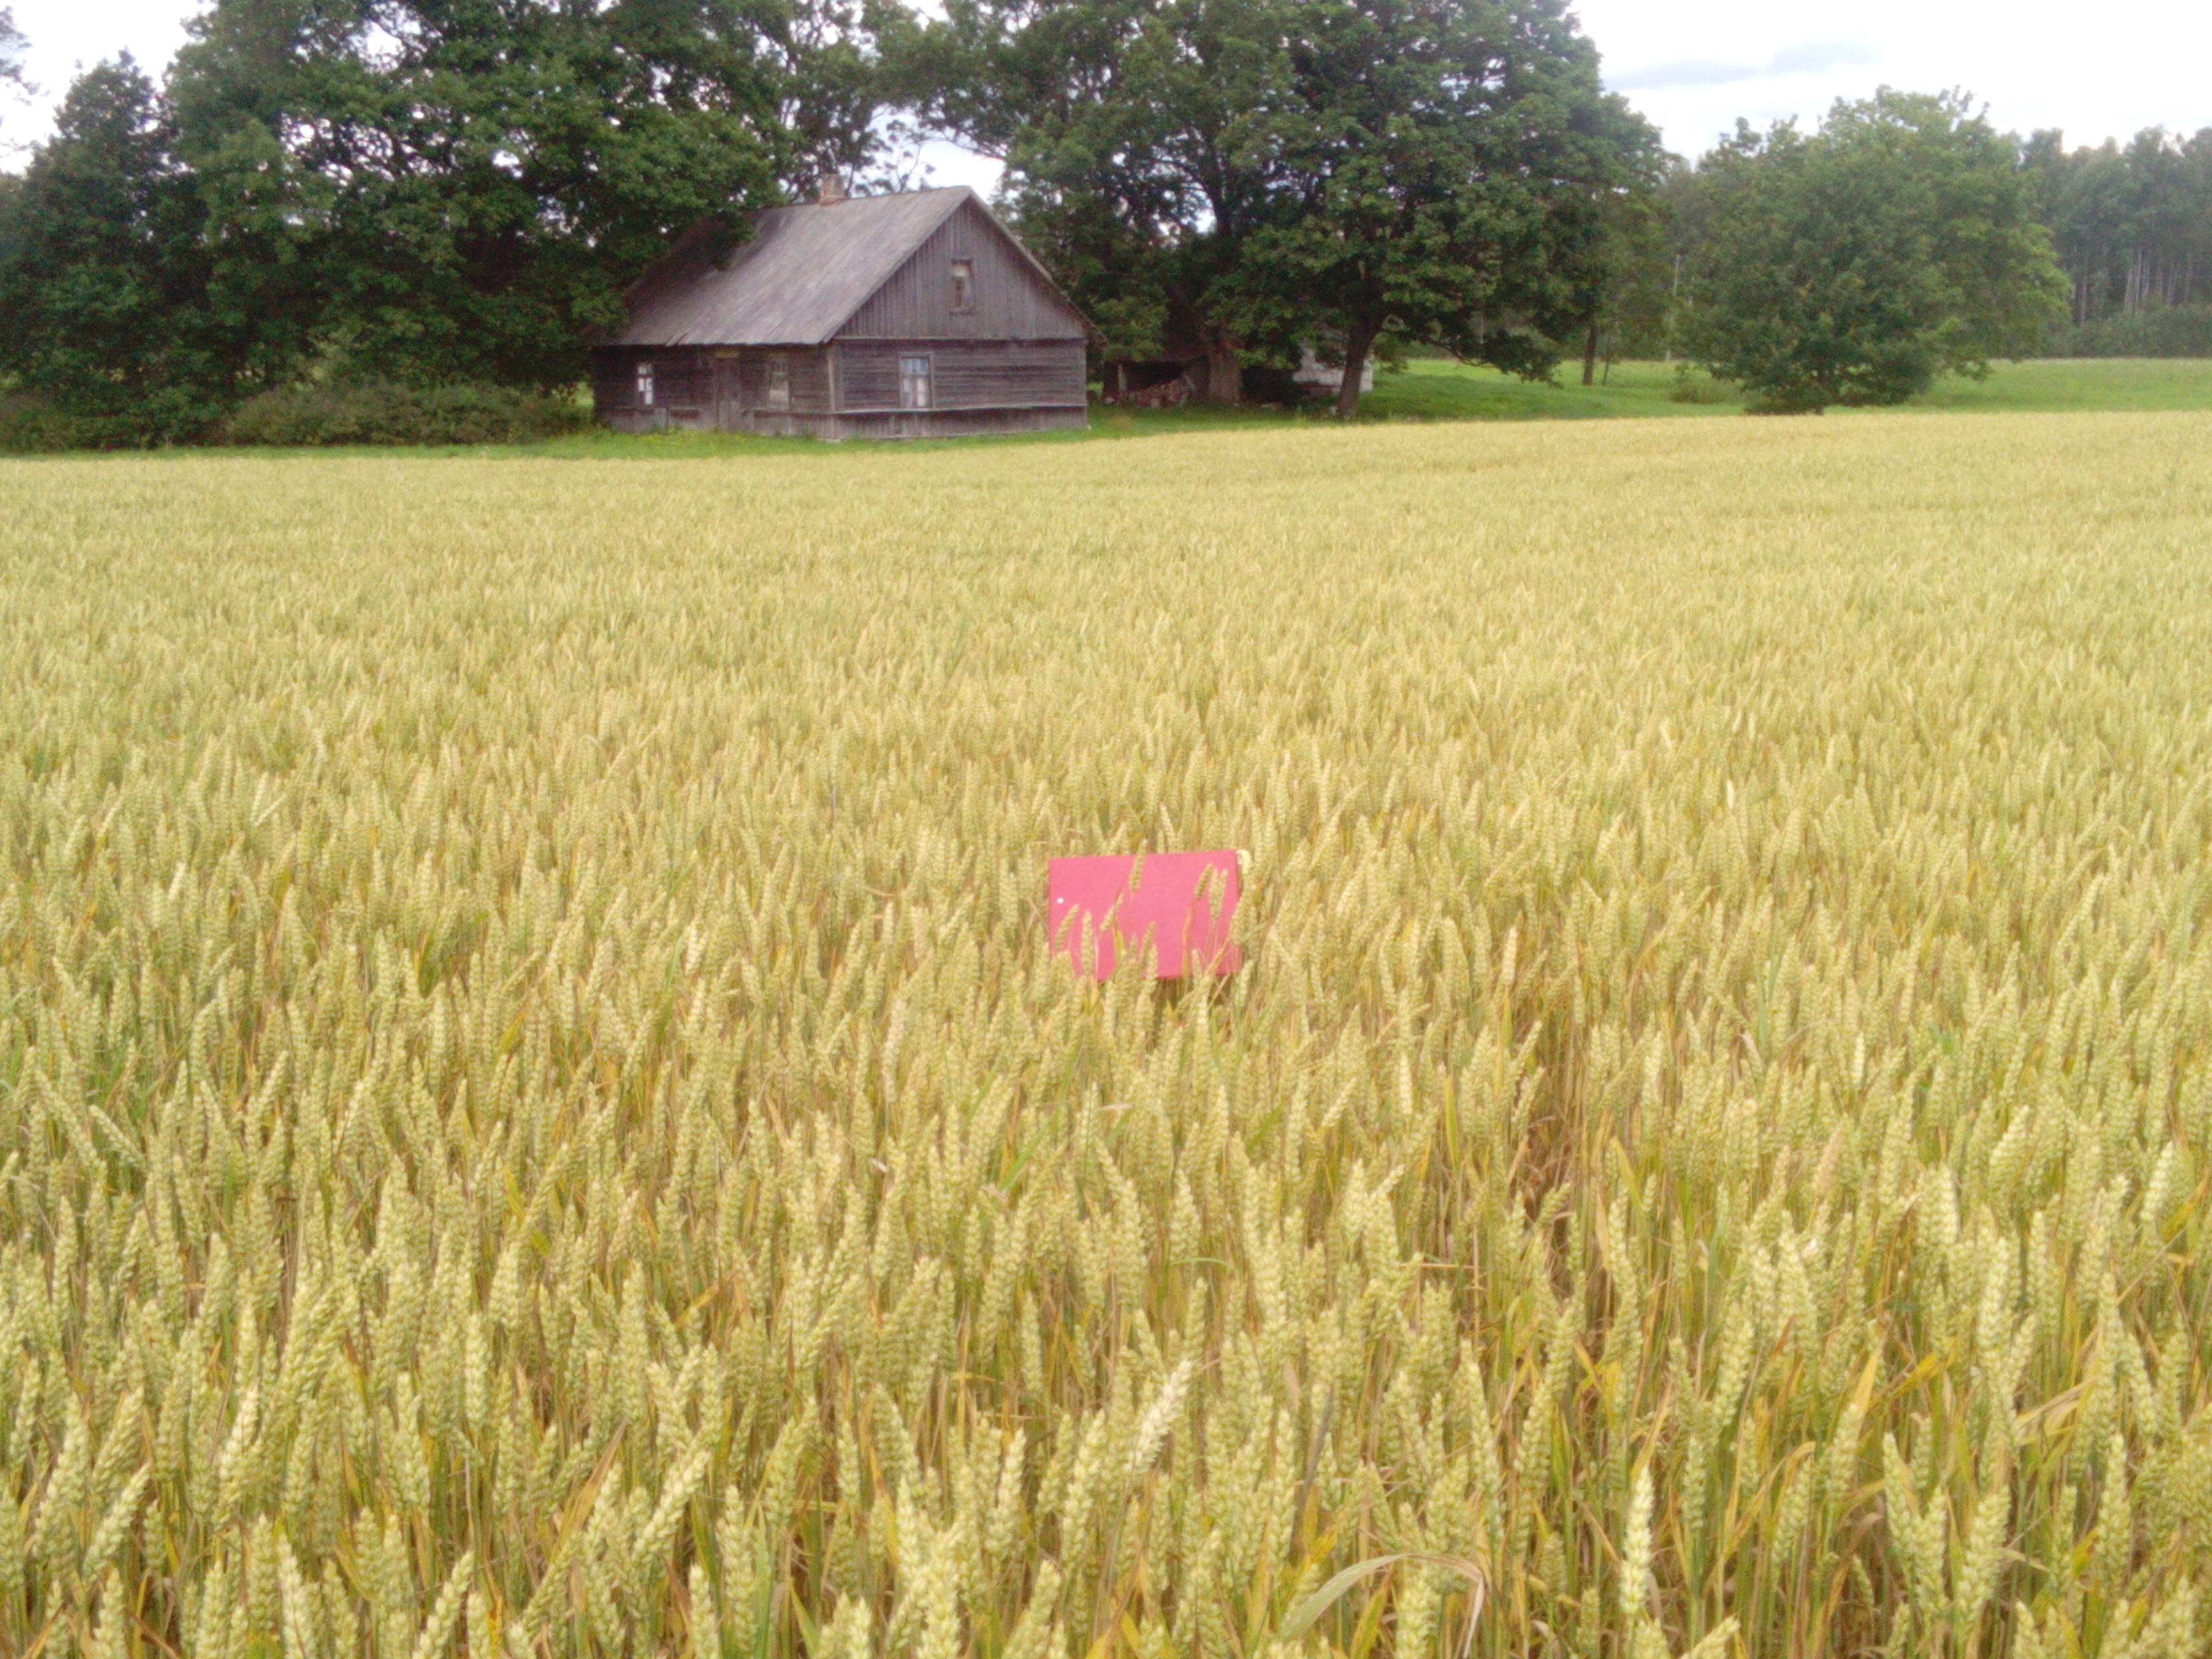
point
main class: Cropland
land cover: Common wheat
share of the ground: > 75 %
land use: Agriculture (excluding fallow land and kitchen gardens)
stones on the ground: < 10 %
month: July
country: LV
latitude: 56.8676
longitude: 22.3067
